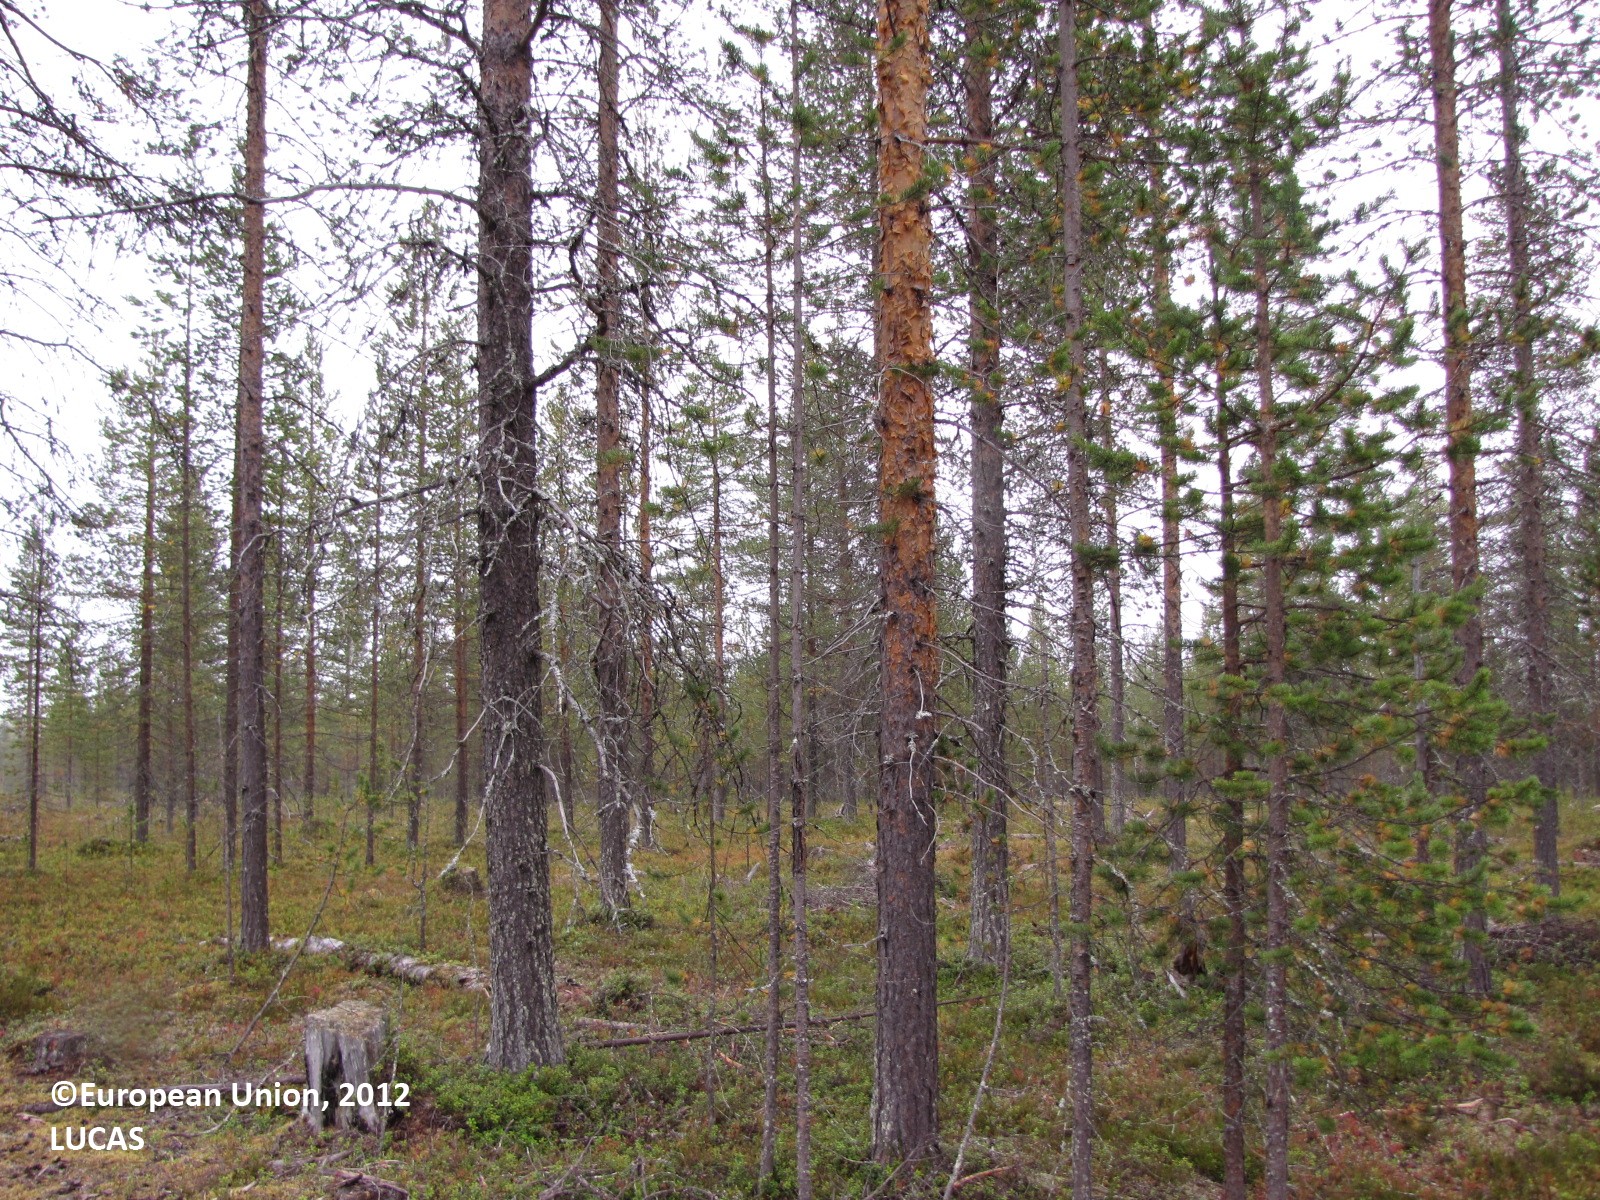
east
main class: Woodland
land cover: Pine dominated coniferous woodland
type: boreal forest
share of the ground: 25 - 50 %
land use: Forestry
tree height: > 5 m
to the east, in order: Pine dominated coniferous woodland
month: August
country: FI
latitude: 67.0988
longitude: 24.8027
